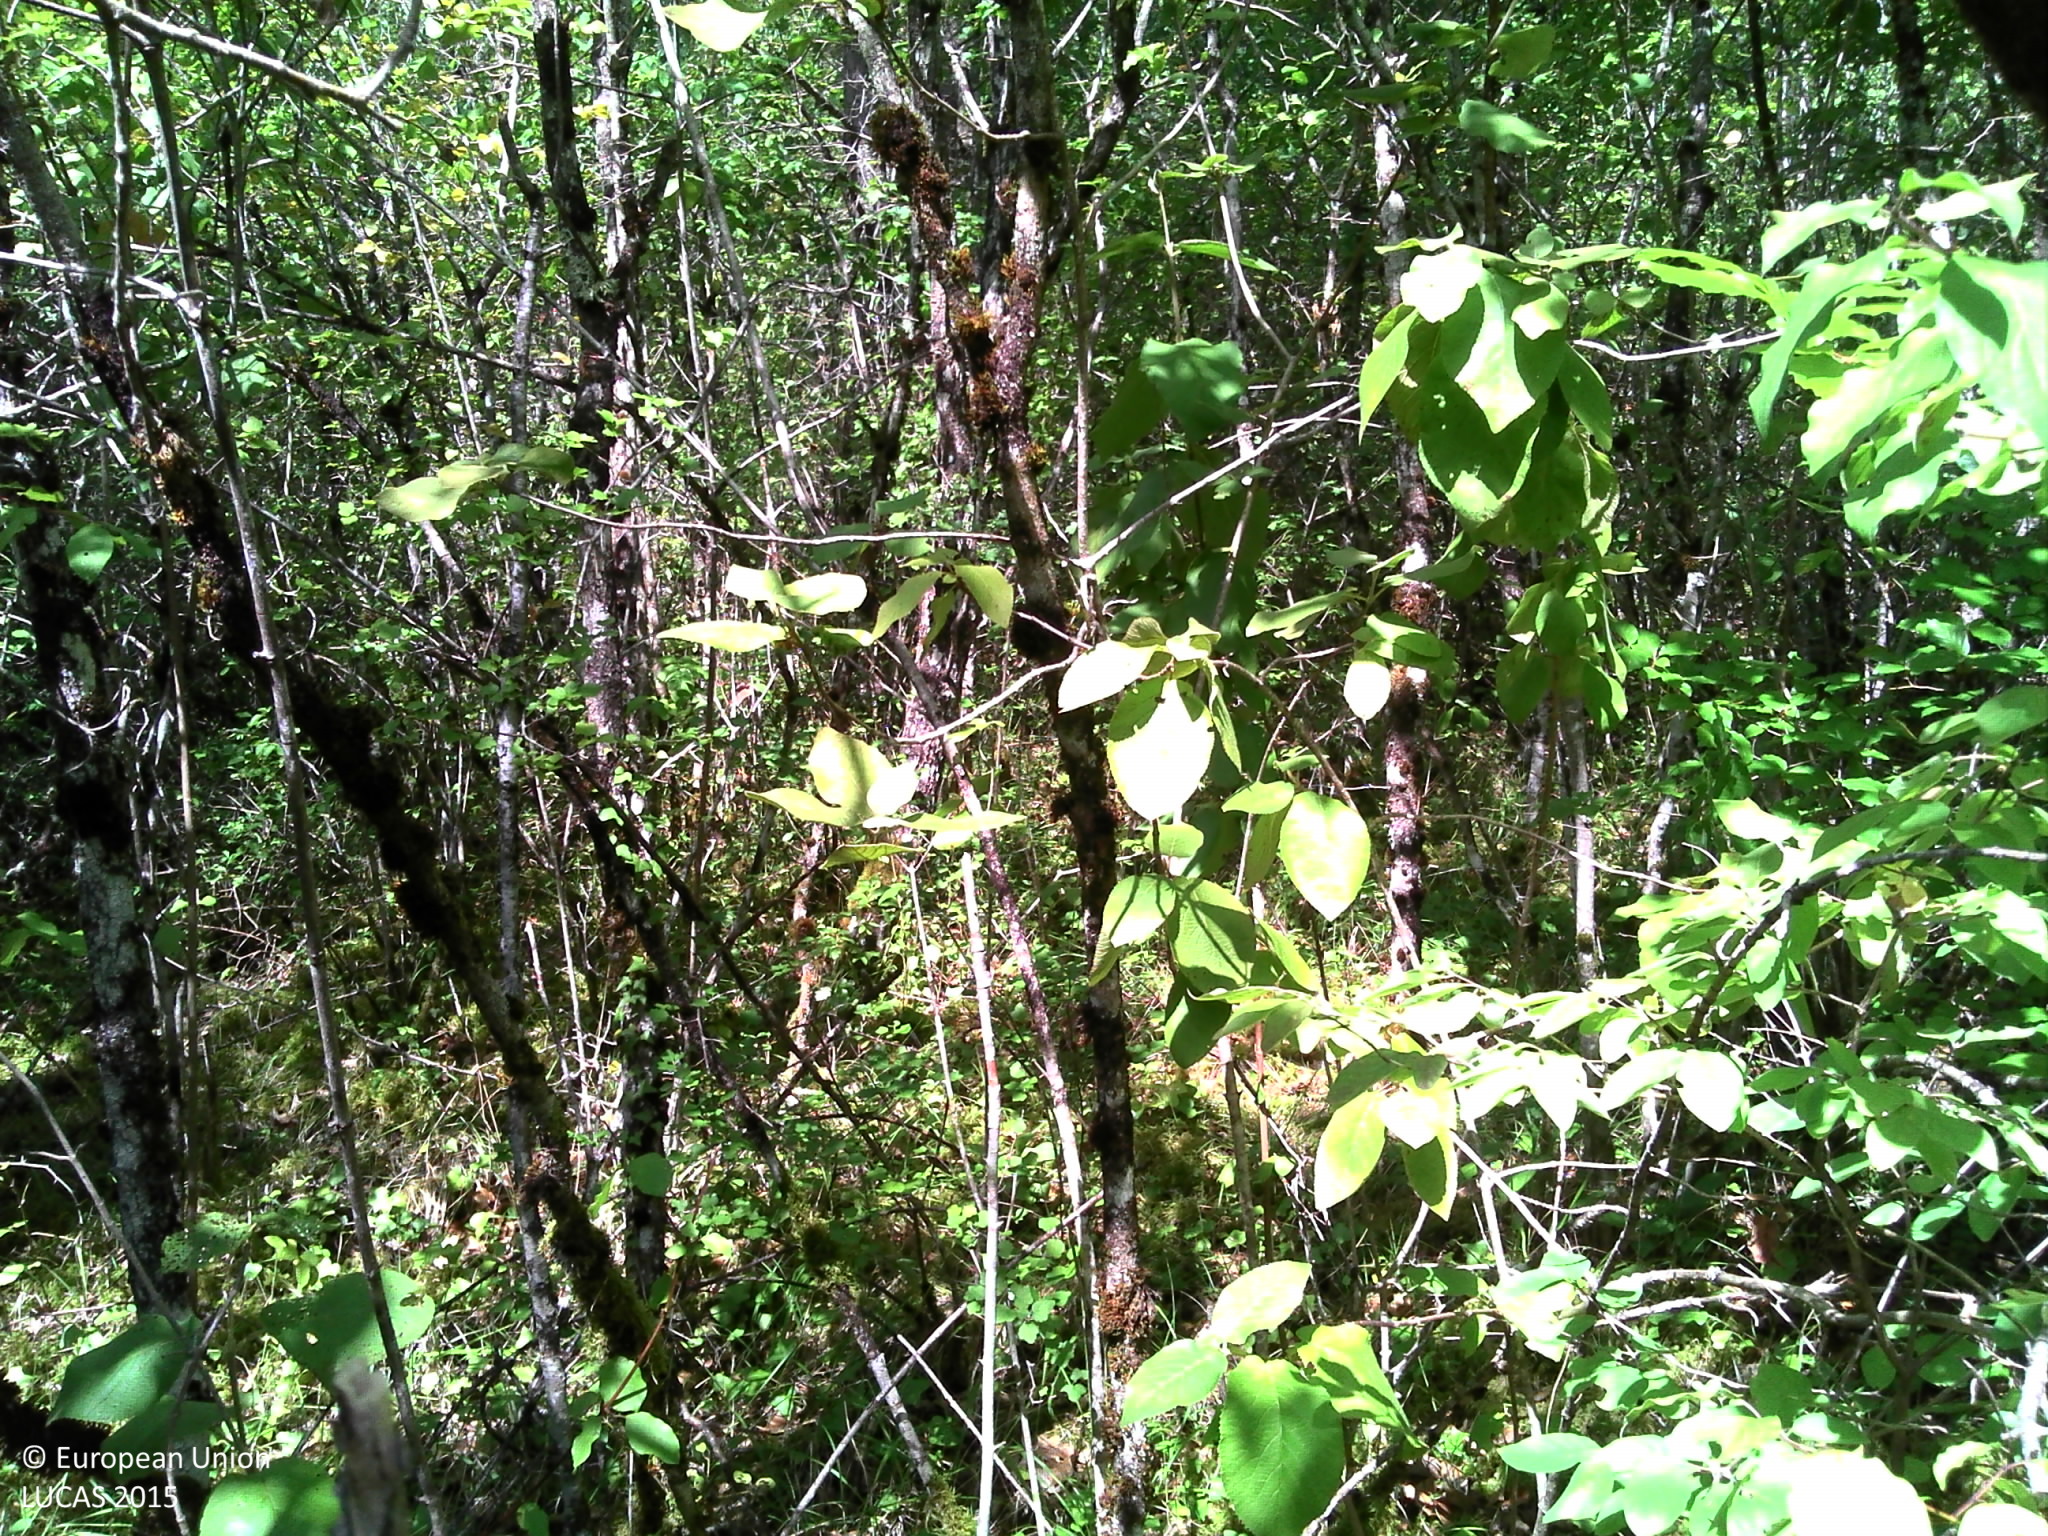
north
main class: Woodland
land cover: Pine dominated mixed woodland
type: hemiboreal forest and nemoral coniferous forest and mixed broadleaved-coniferous forest
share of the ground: > 75 %
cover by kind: broadleaved forest trees 60 %, coniferous forest trees 25 %, herbaceous plants 10 %, lichens and mosses 5 %
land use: Forestry
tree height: > 5 m
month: August
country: FR
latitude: 47.7278
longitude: 4.9197
